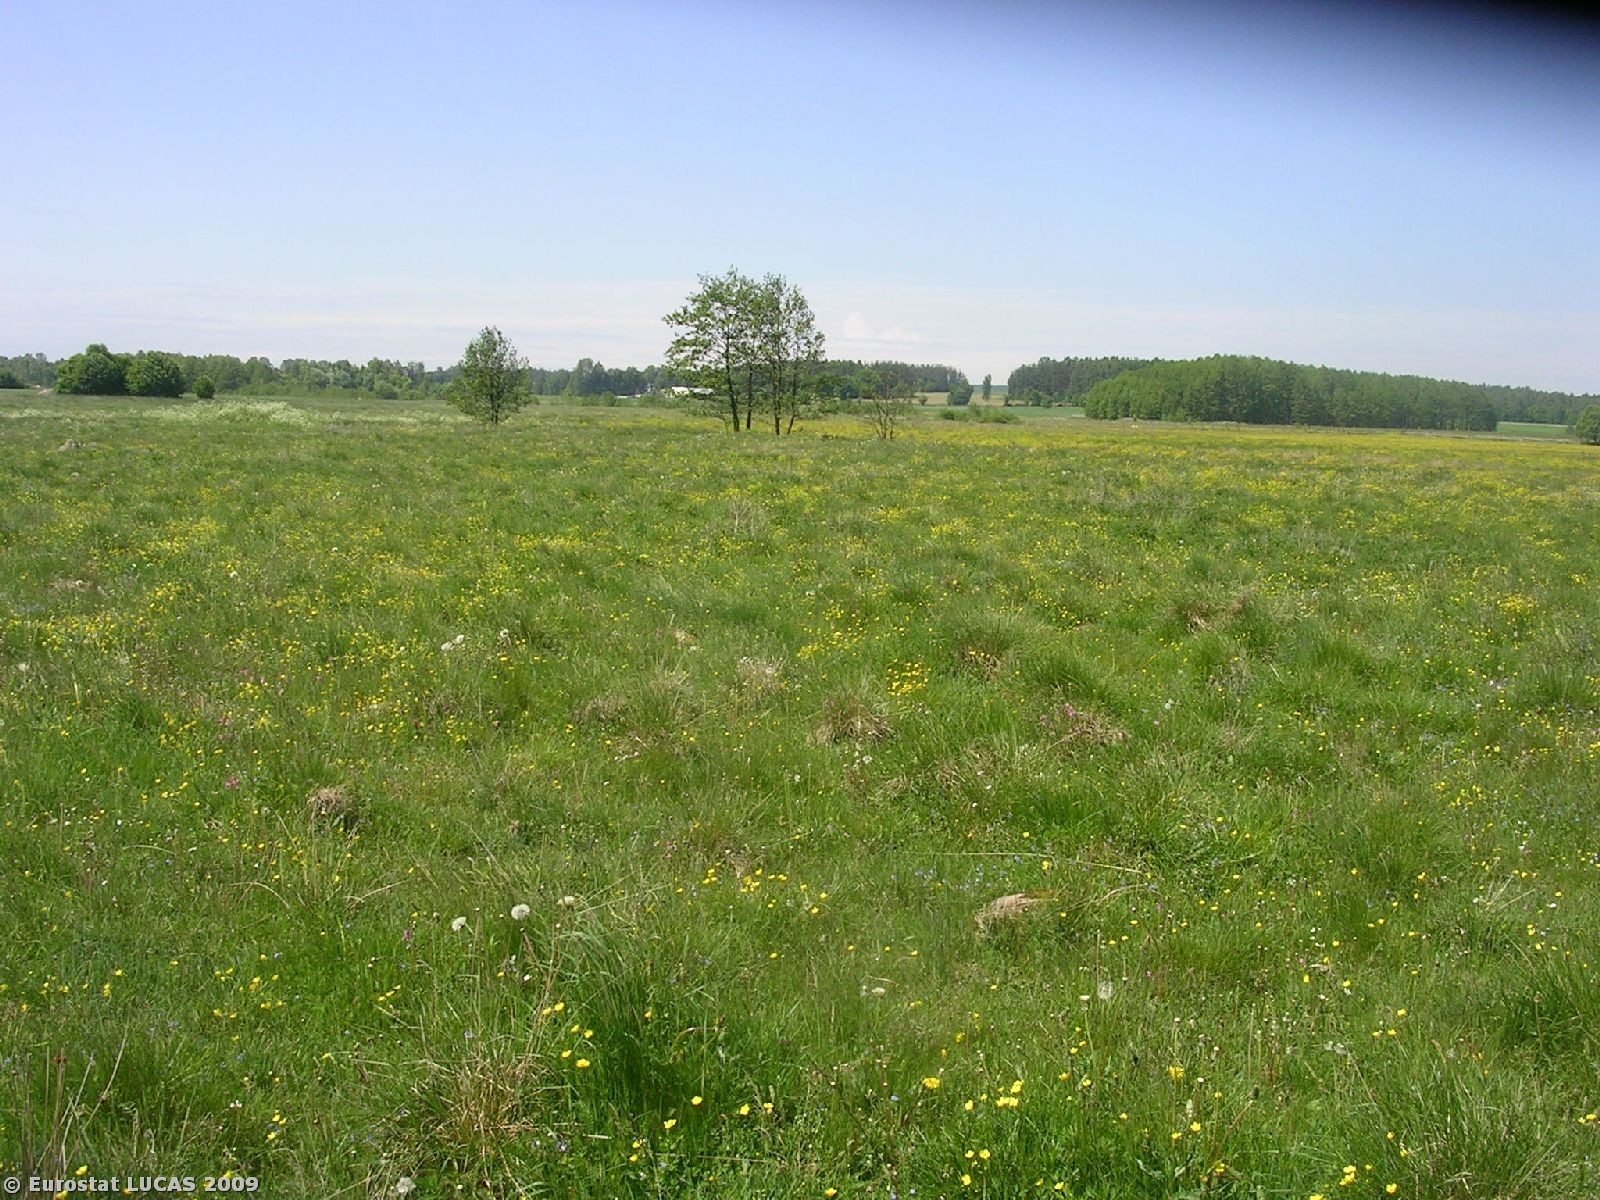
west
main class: Grassland
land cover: Grassland without tree/shrub cover
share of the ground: > 75 %
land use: Agriculture (excluding fallow land and kitchen gardens)
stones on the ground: < 10 %
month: May
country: PL
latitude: 53.5137
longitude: 23.3667
